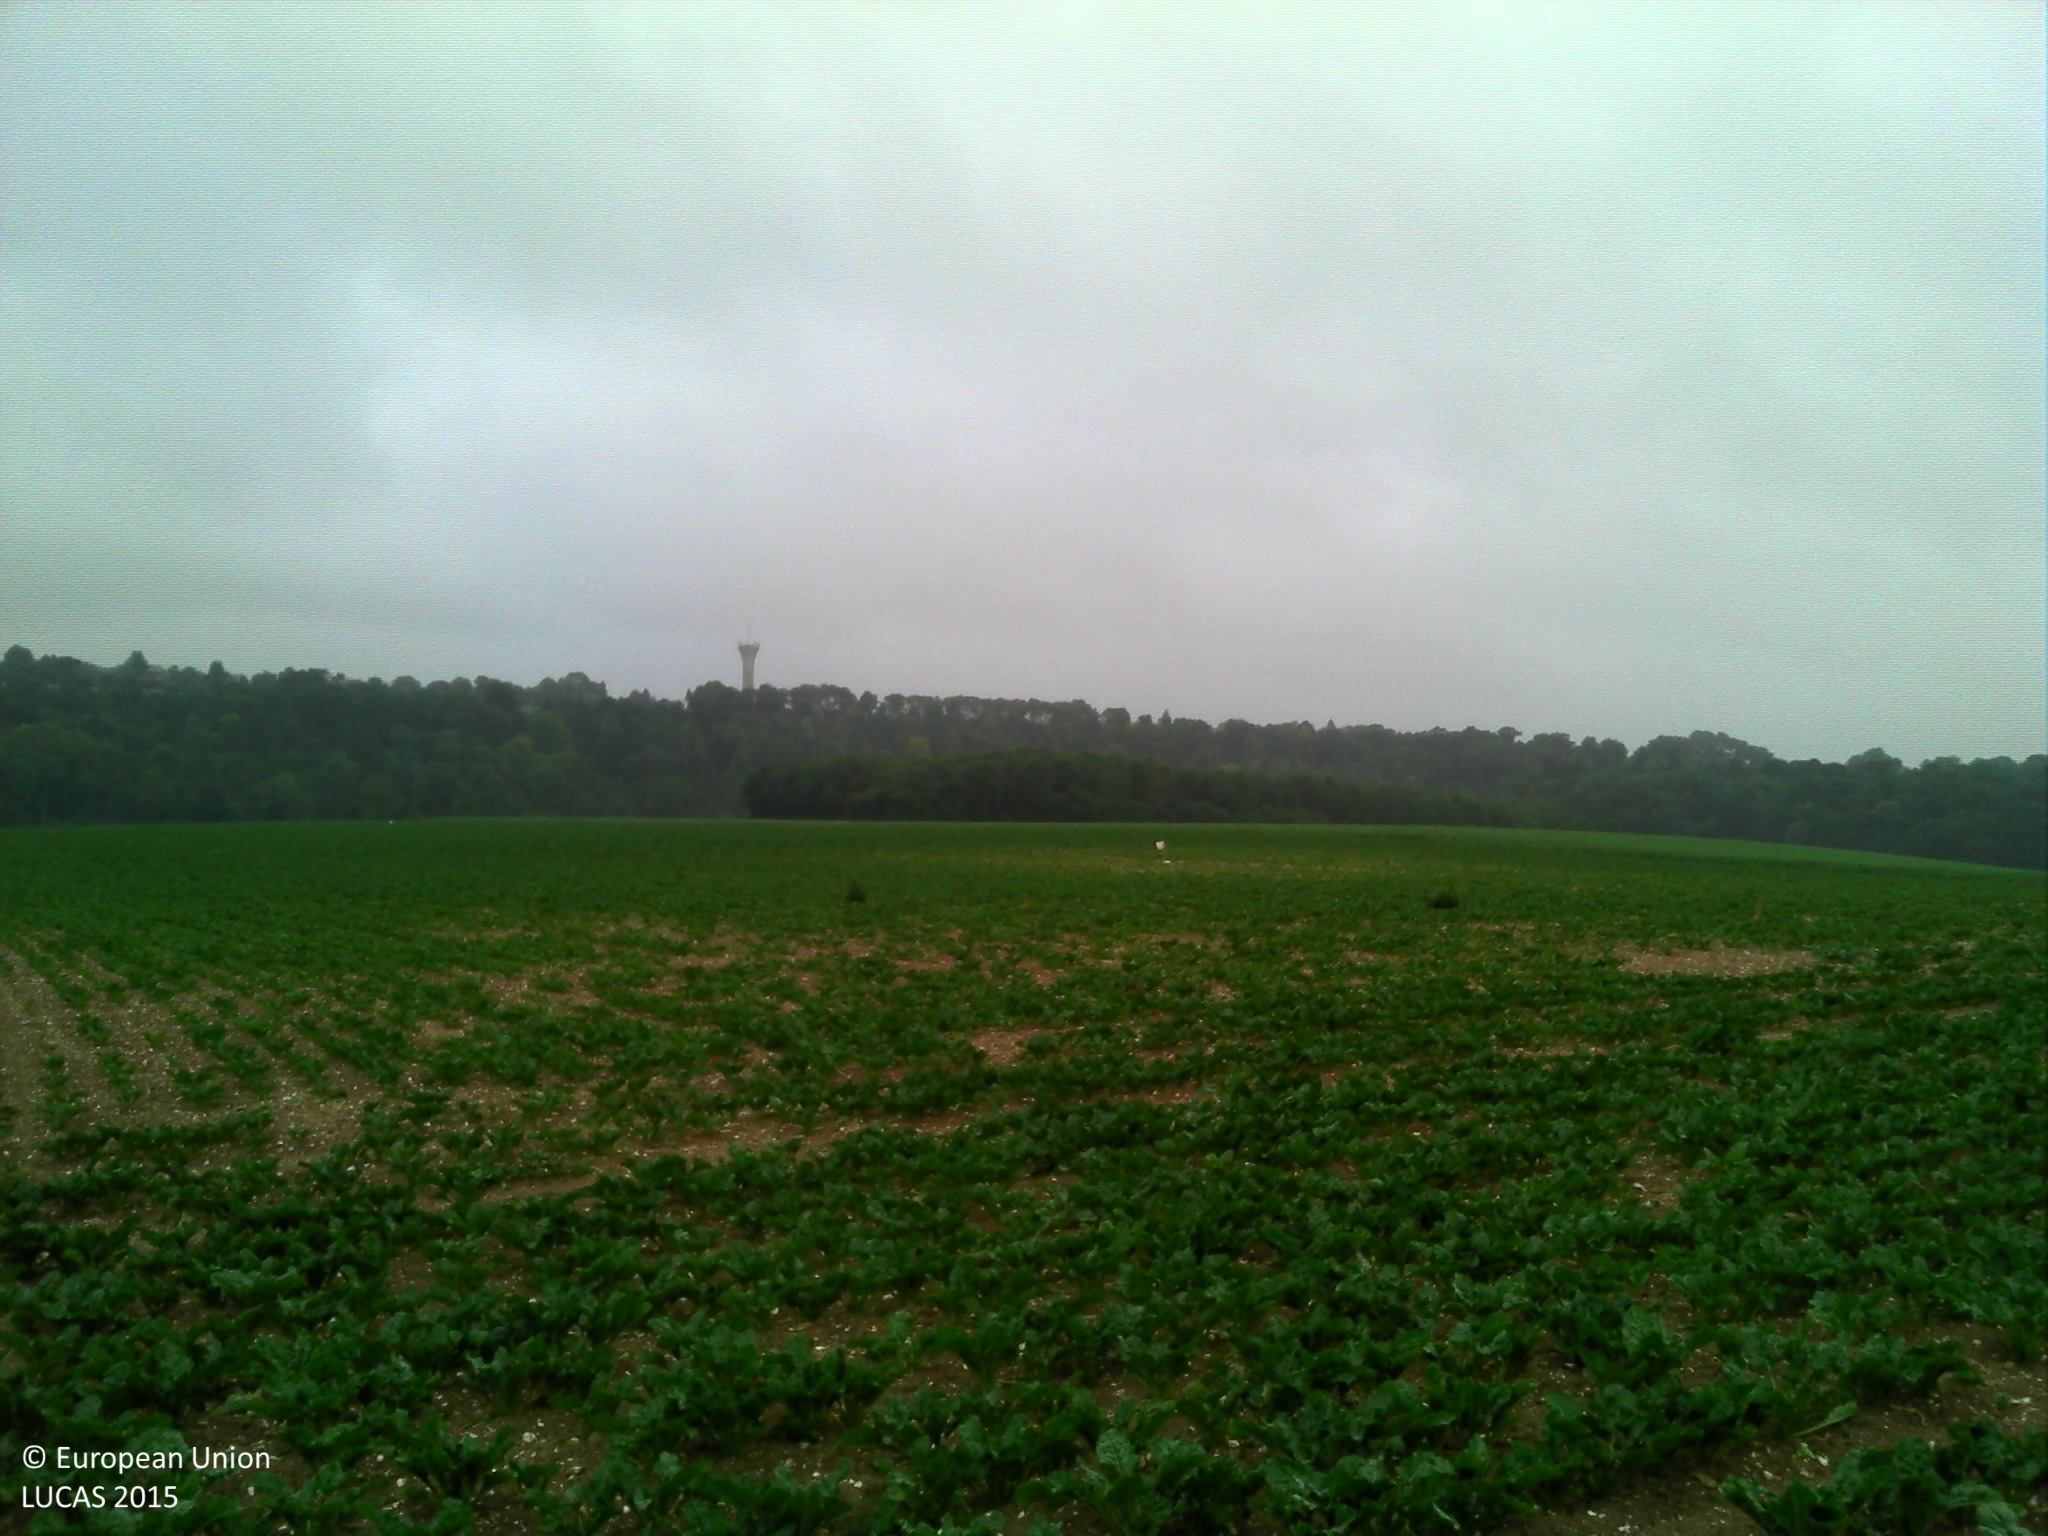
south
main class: Cropland
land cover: Sugar beet
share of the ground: 50 - 75 %
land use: Agriculture (excluding fallow land and kitchen gardens)
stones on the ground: < 10 %
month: June
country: FR
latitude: 49.4635
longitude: 2.4404
